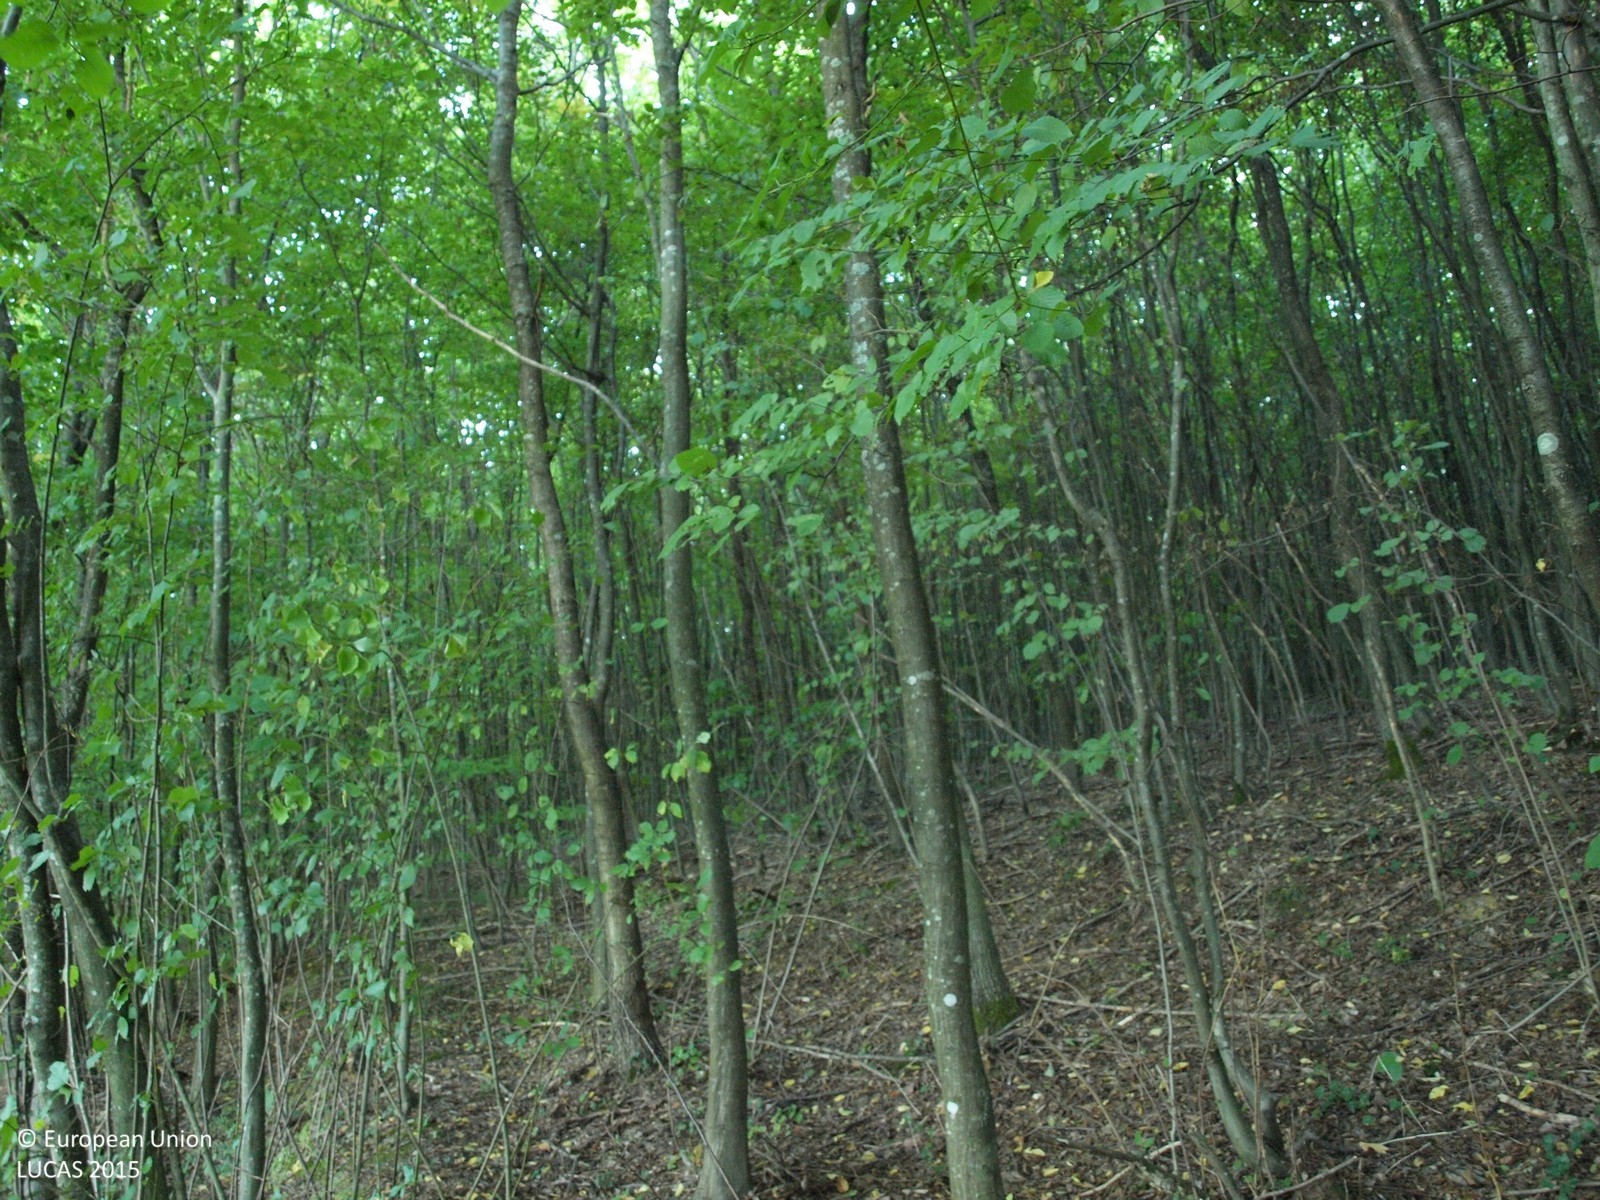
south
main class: Woodland
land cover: Broadleaved woodland
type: beech forest
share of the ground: > 75 %
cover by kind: broadleaved forest trees 100 %
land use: Forestry
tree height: > 5 m
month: August
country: HR
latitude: 46.0941
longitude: 16.5838
